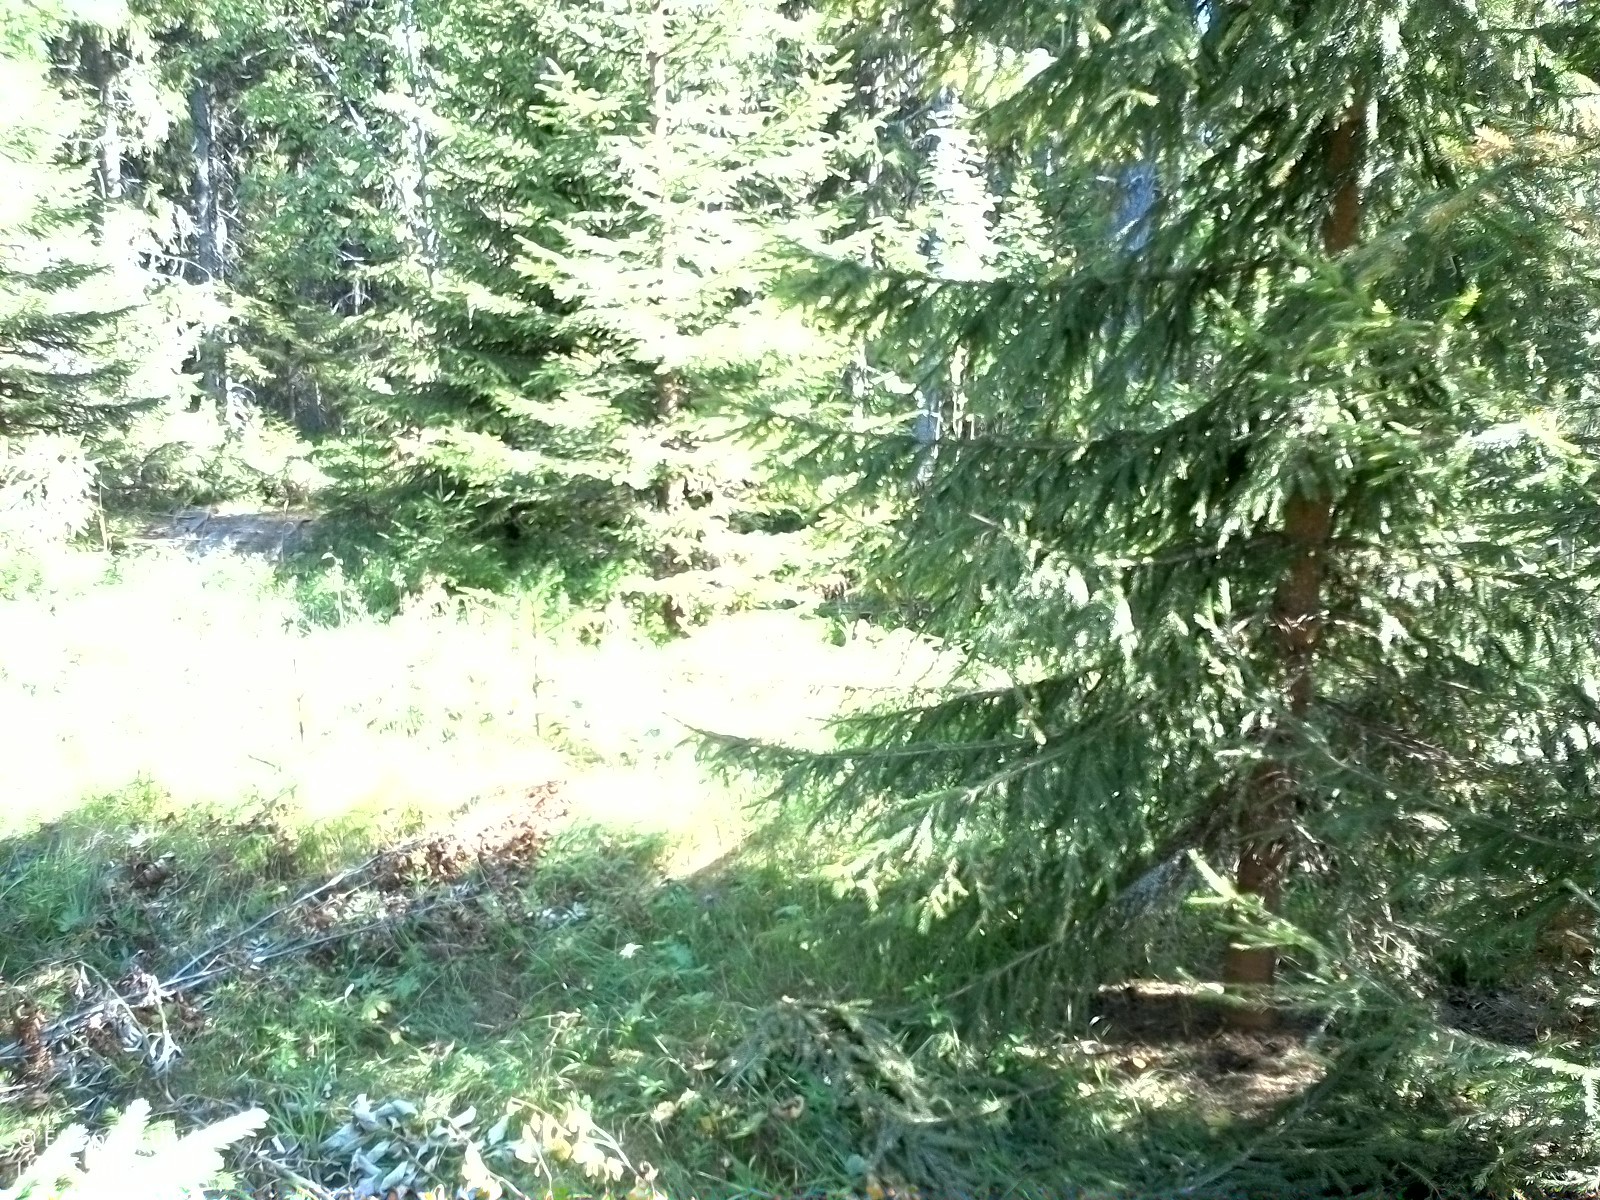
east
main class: Woodland
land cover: Spruce dominated mixed woodland
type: boreal forest
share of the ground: 50 - 75 %
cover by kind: coniferous forest trees 40 %, herbaceous plants 40 %, broadleaved forest trees 15 %
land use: Forestry
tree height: > 5 m
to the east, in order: Spruce dominated mixed woodland; Spruce dominated coniferous woodland; Spruce dominated mixed woodland; Spruce dominated coniferous woodland
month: August
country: SE
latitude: 62.4039
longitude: 16.8105
